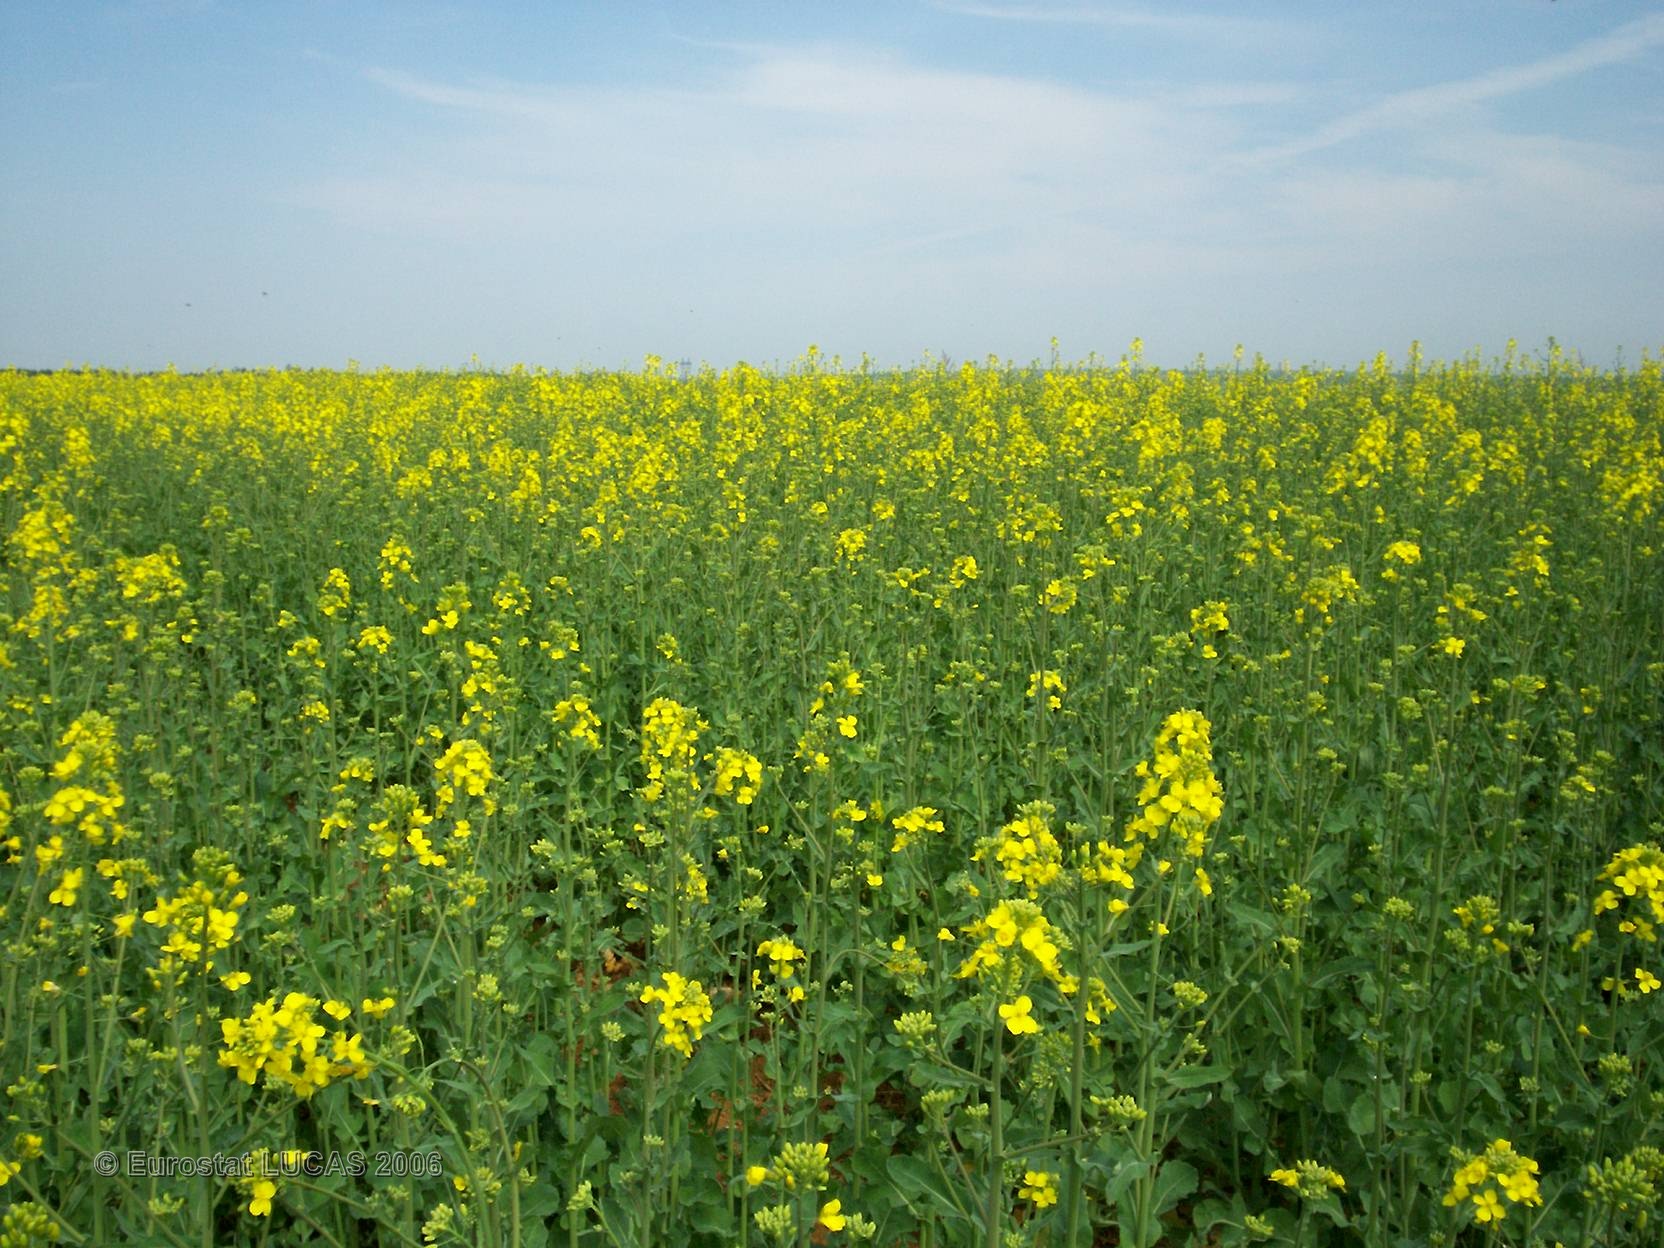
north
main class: Cropland
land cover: Rape and turnip rape
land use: Agriculture (excluding fallow land and kitchen gardens)
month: May
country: FR
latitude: 48.5285
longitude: 5.9782
